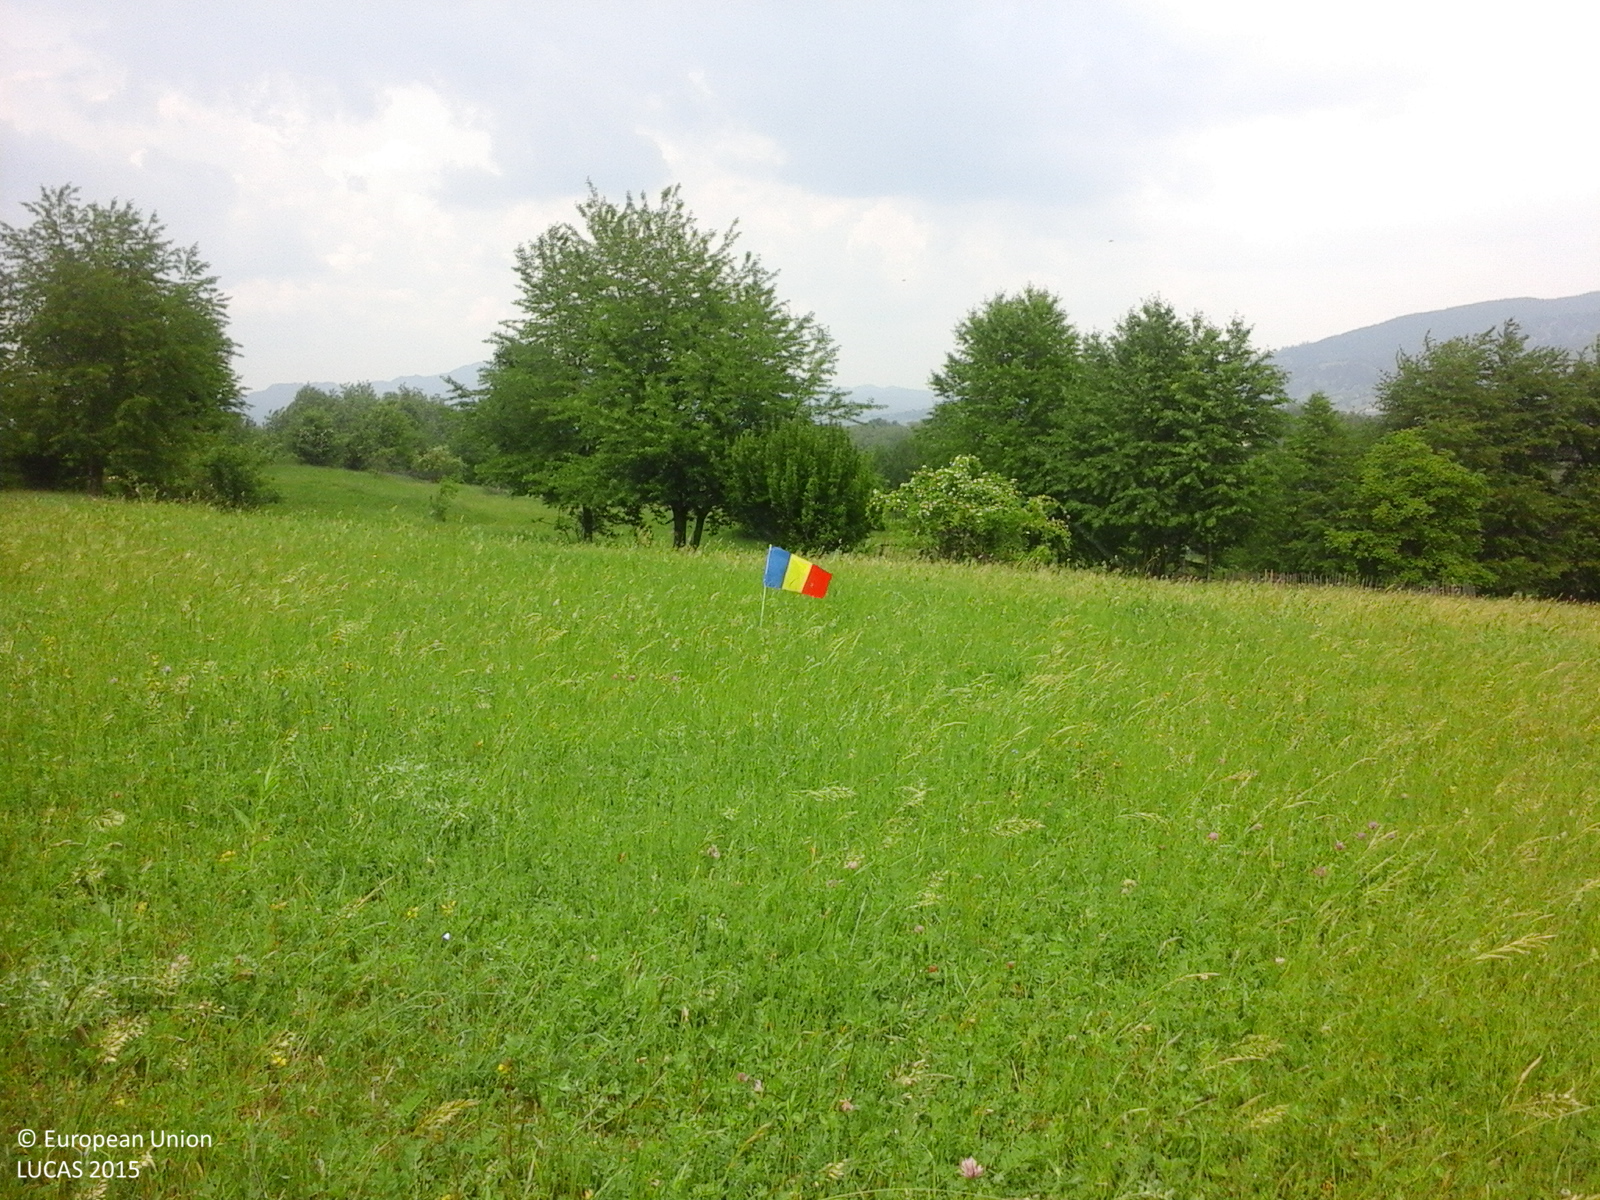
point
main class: Grassland
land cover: Grassland without tree/shrub cover
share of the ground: > 75 %
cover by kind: herbaceous plants 100 %
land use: Agriculture (excluding fallow land and kitchen gardens)
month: June
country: RO
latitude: 46.3846
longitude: 26.4771
